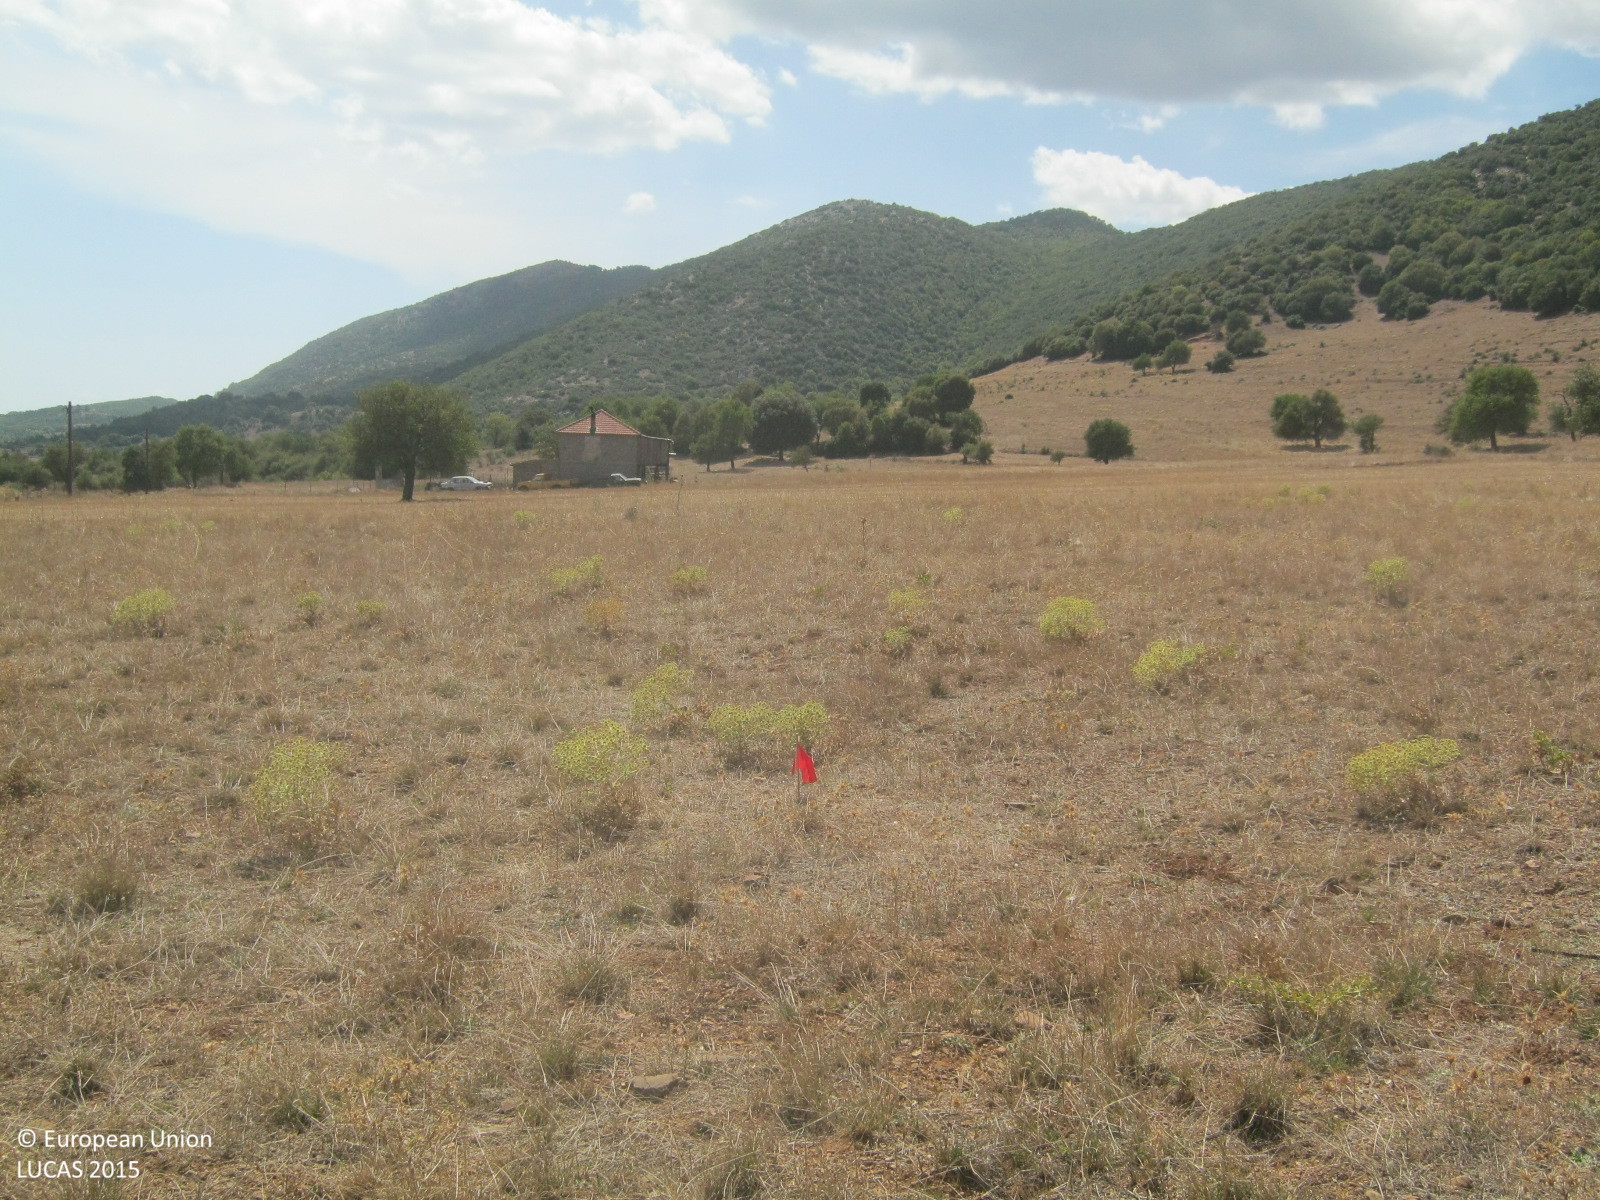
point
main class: Grassland
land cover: Spontaneously vegetated surfaces
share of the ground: > 75 %
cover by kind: herbaceous plants 95 %, unconsolidated bare surface 5 %
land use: Agriculture (excluding fallow land and kitchen gardens)
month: September
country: GR
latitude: 37.9623
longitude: 22.0880
